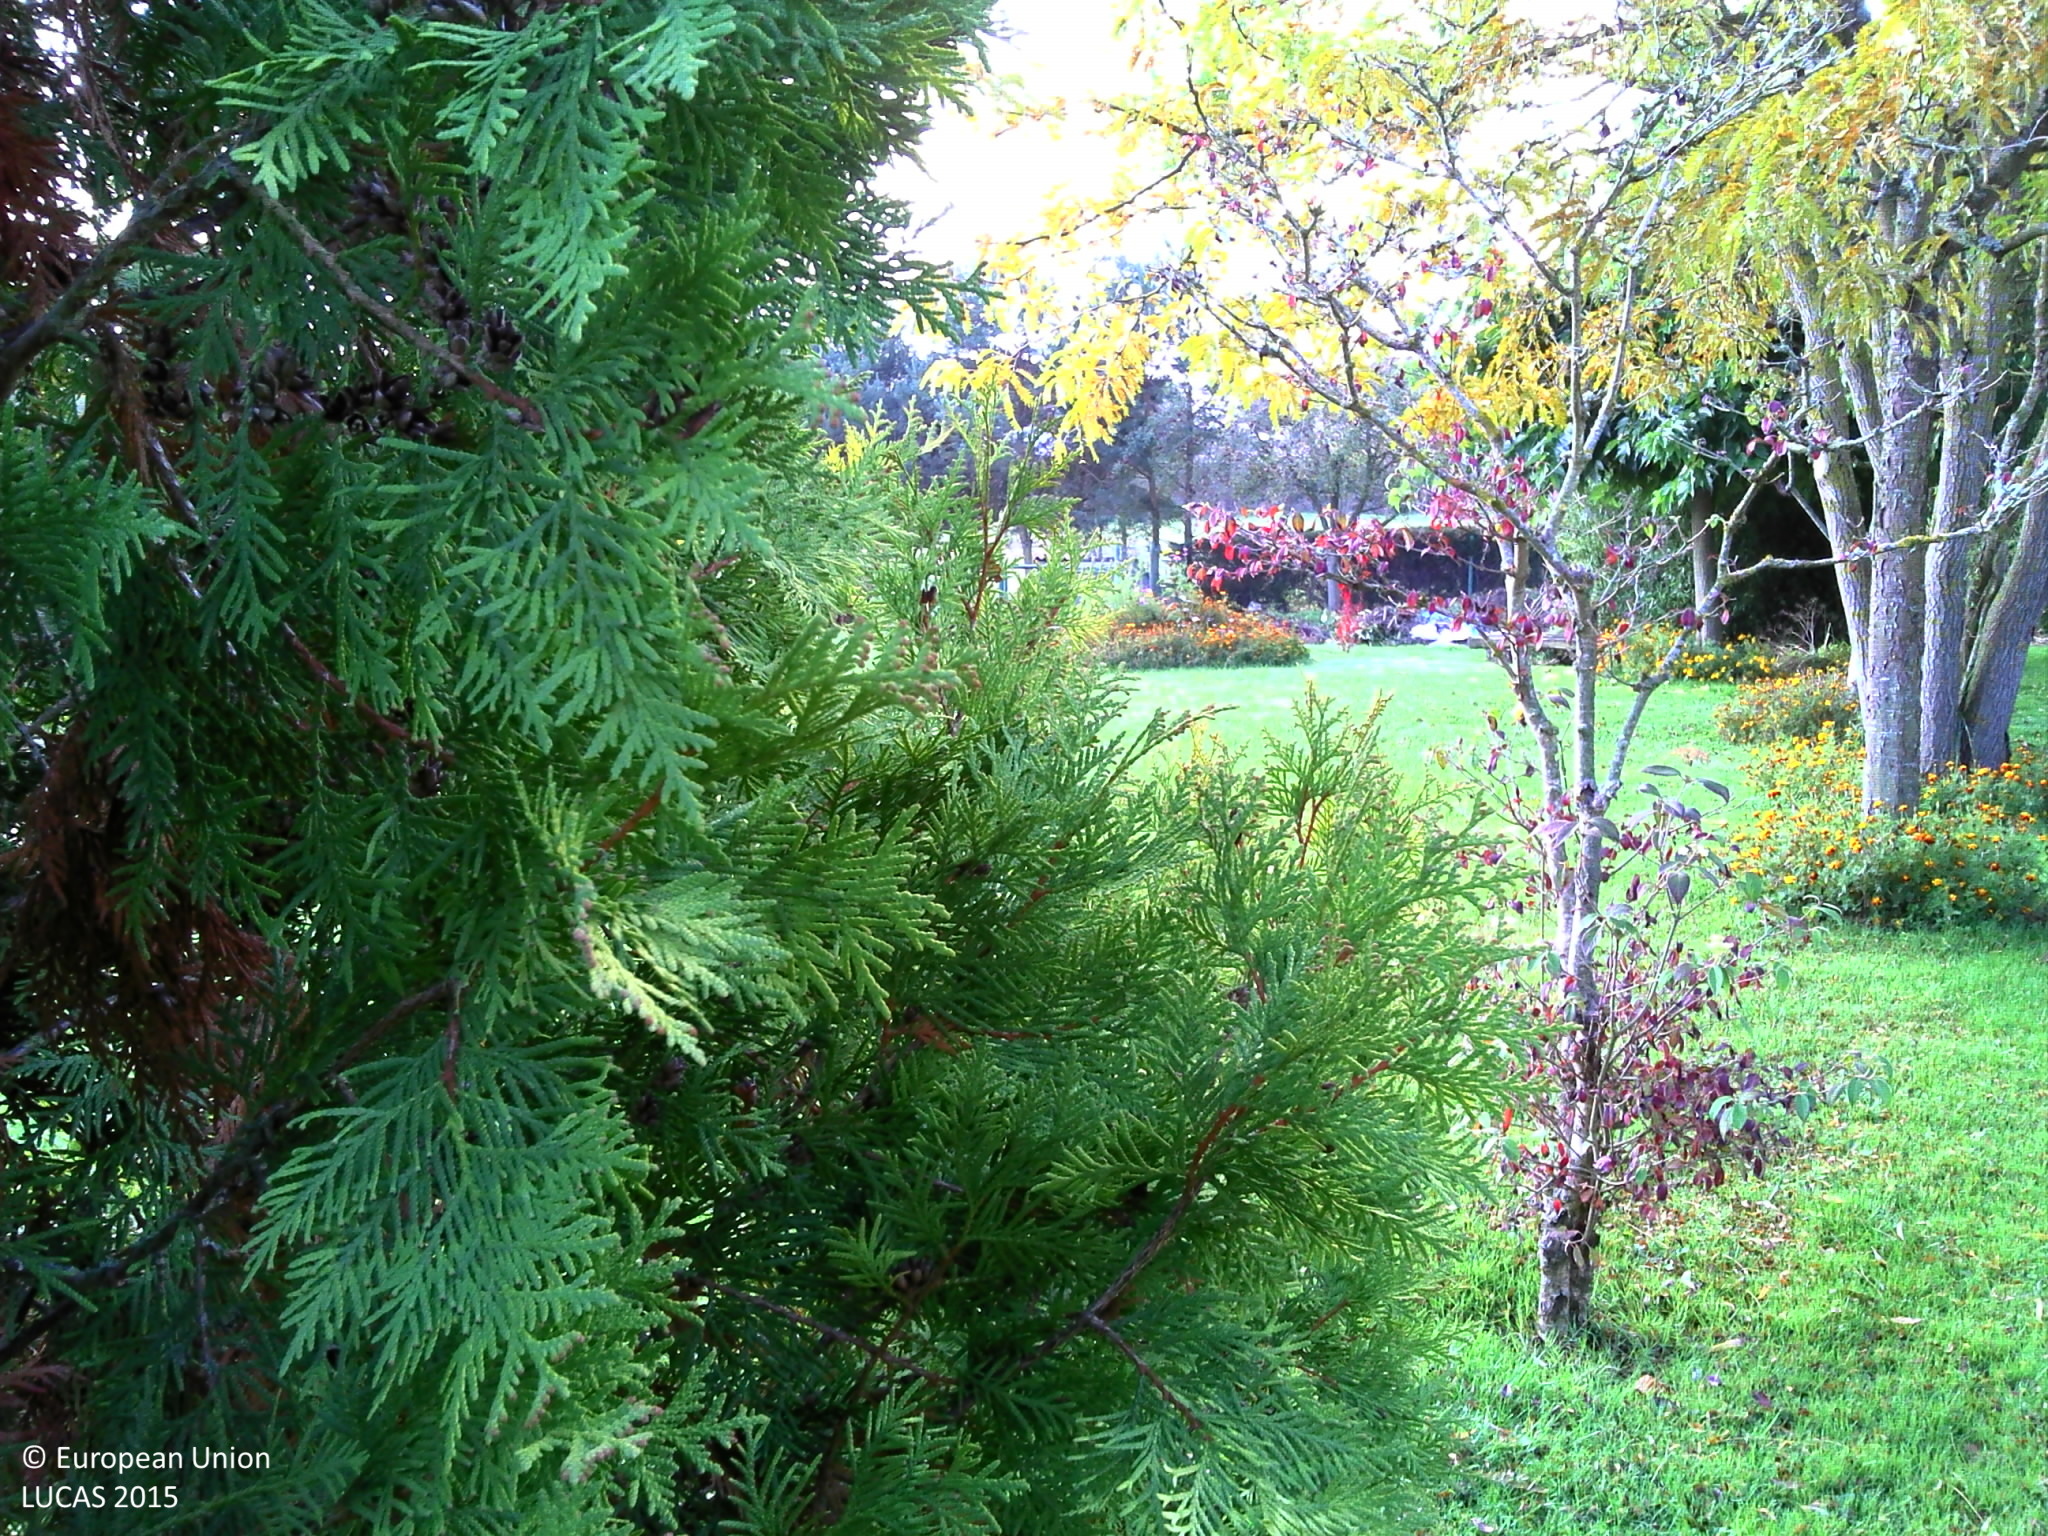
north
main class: Grassland
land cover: Grassland with sparse tree/shrub cover
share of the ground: > 75 %
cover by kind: herbaceous plants 95 %, coniferous forest trees 5 %
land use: Residential
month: October
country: FR
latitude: 46.1275
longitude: 2.8147
